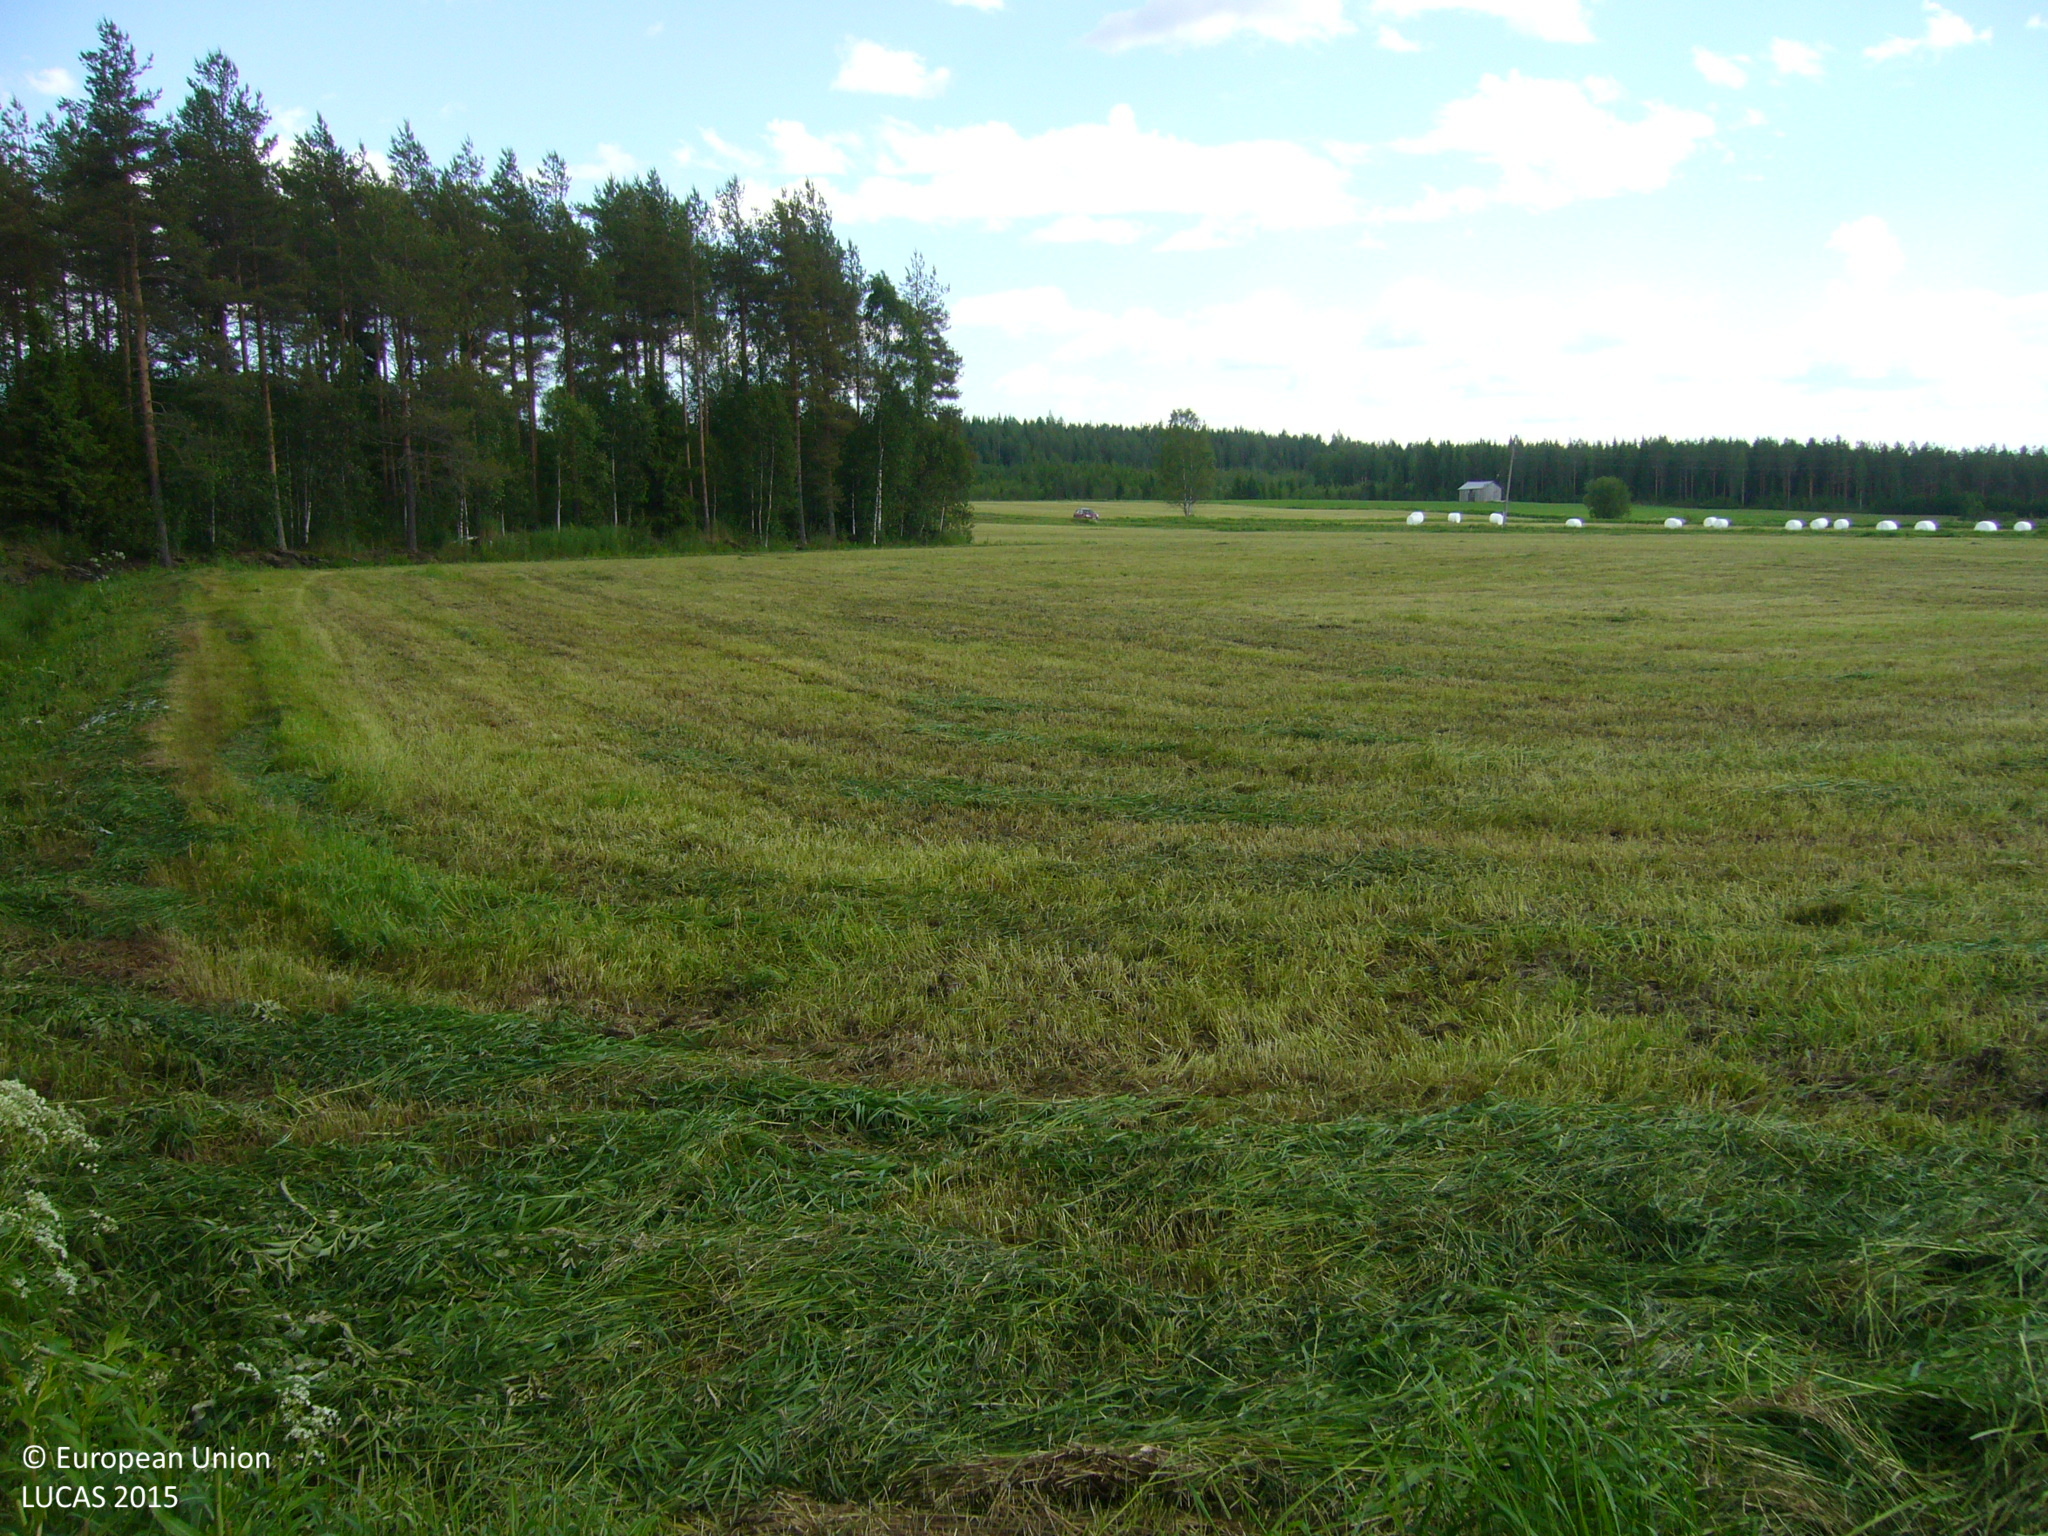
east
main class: Woodland
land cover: Broadleaved woodland
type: boreal forest
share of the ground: > 75 %
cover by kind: broadleaved forest trees 90 %, coniferous forest trees 5 %, shrubs 5 %
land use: Forestry
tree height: > 5 m
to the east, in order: Broadleaved woodland; Other mixed woodland; Pine dominated mixed woodland; Ditches and canals; Temporary grasslands; Grass margins; Ditches and canals; Grass margins; Temporary grasslands; Grass margins; Ditches and canals; Grass margins; Temporary grasslands
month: June
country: FI
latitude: 63.8449
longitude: 26.2818
